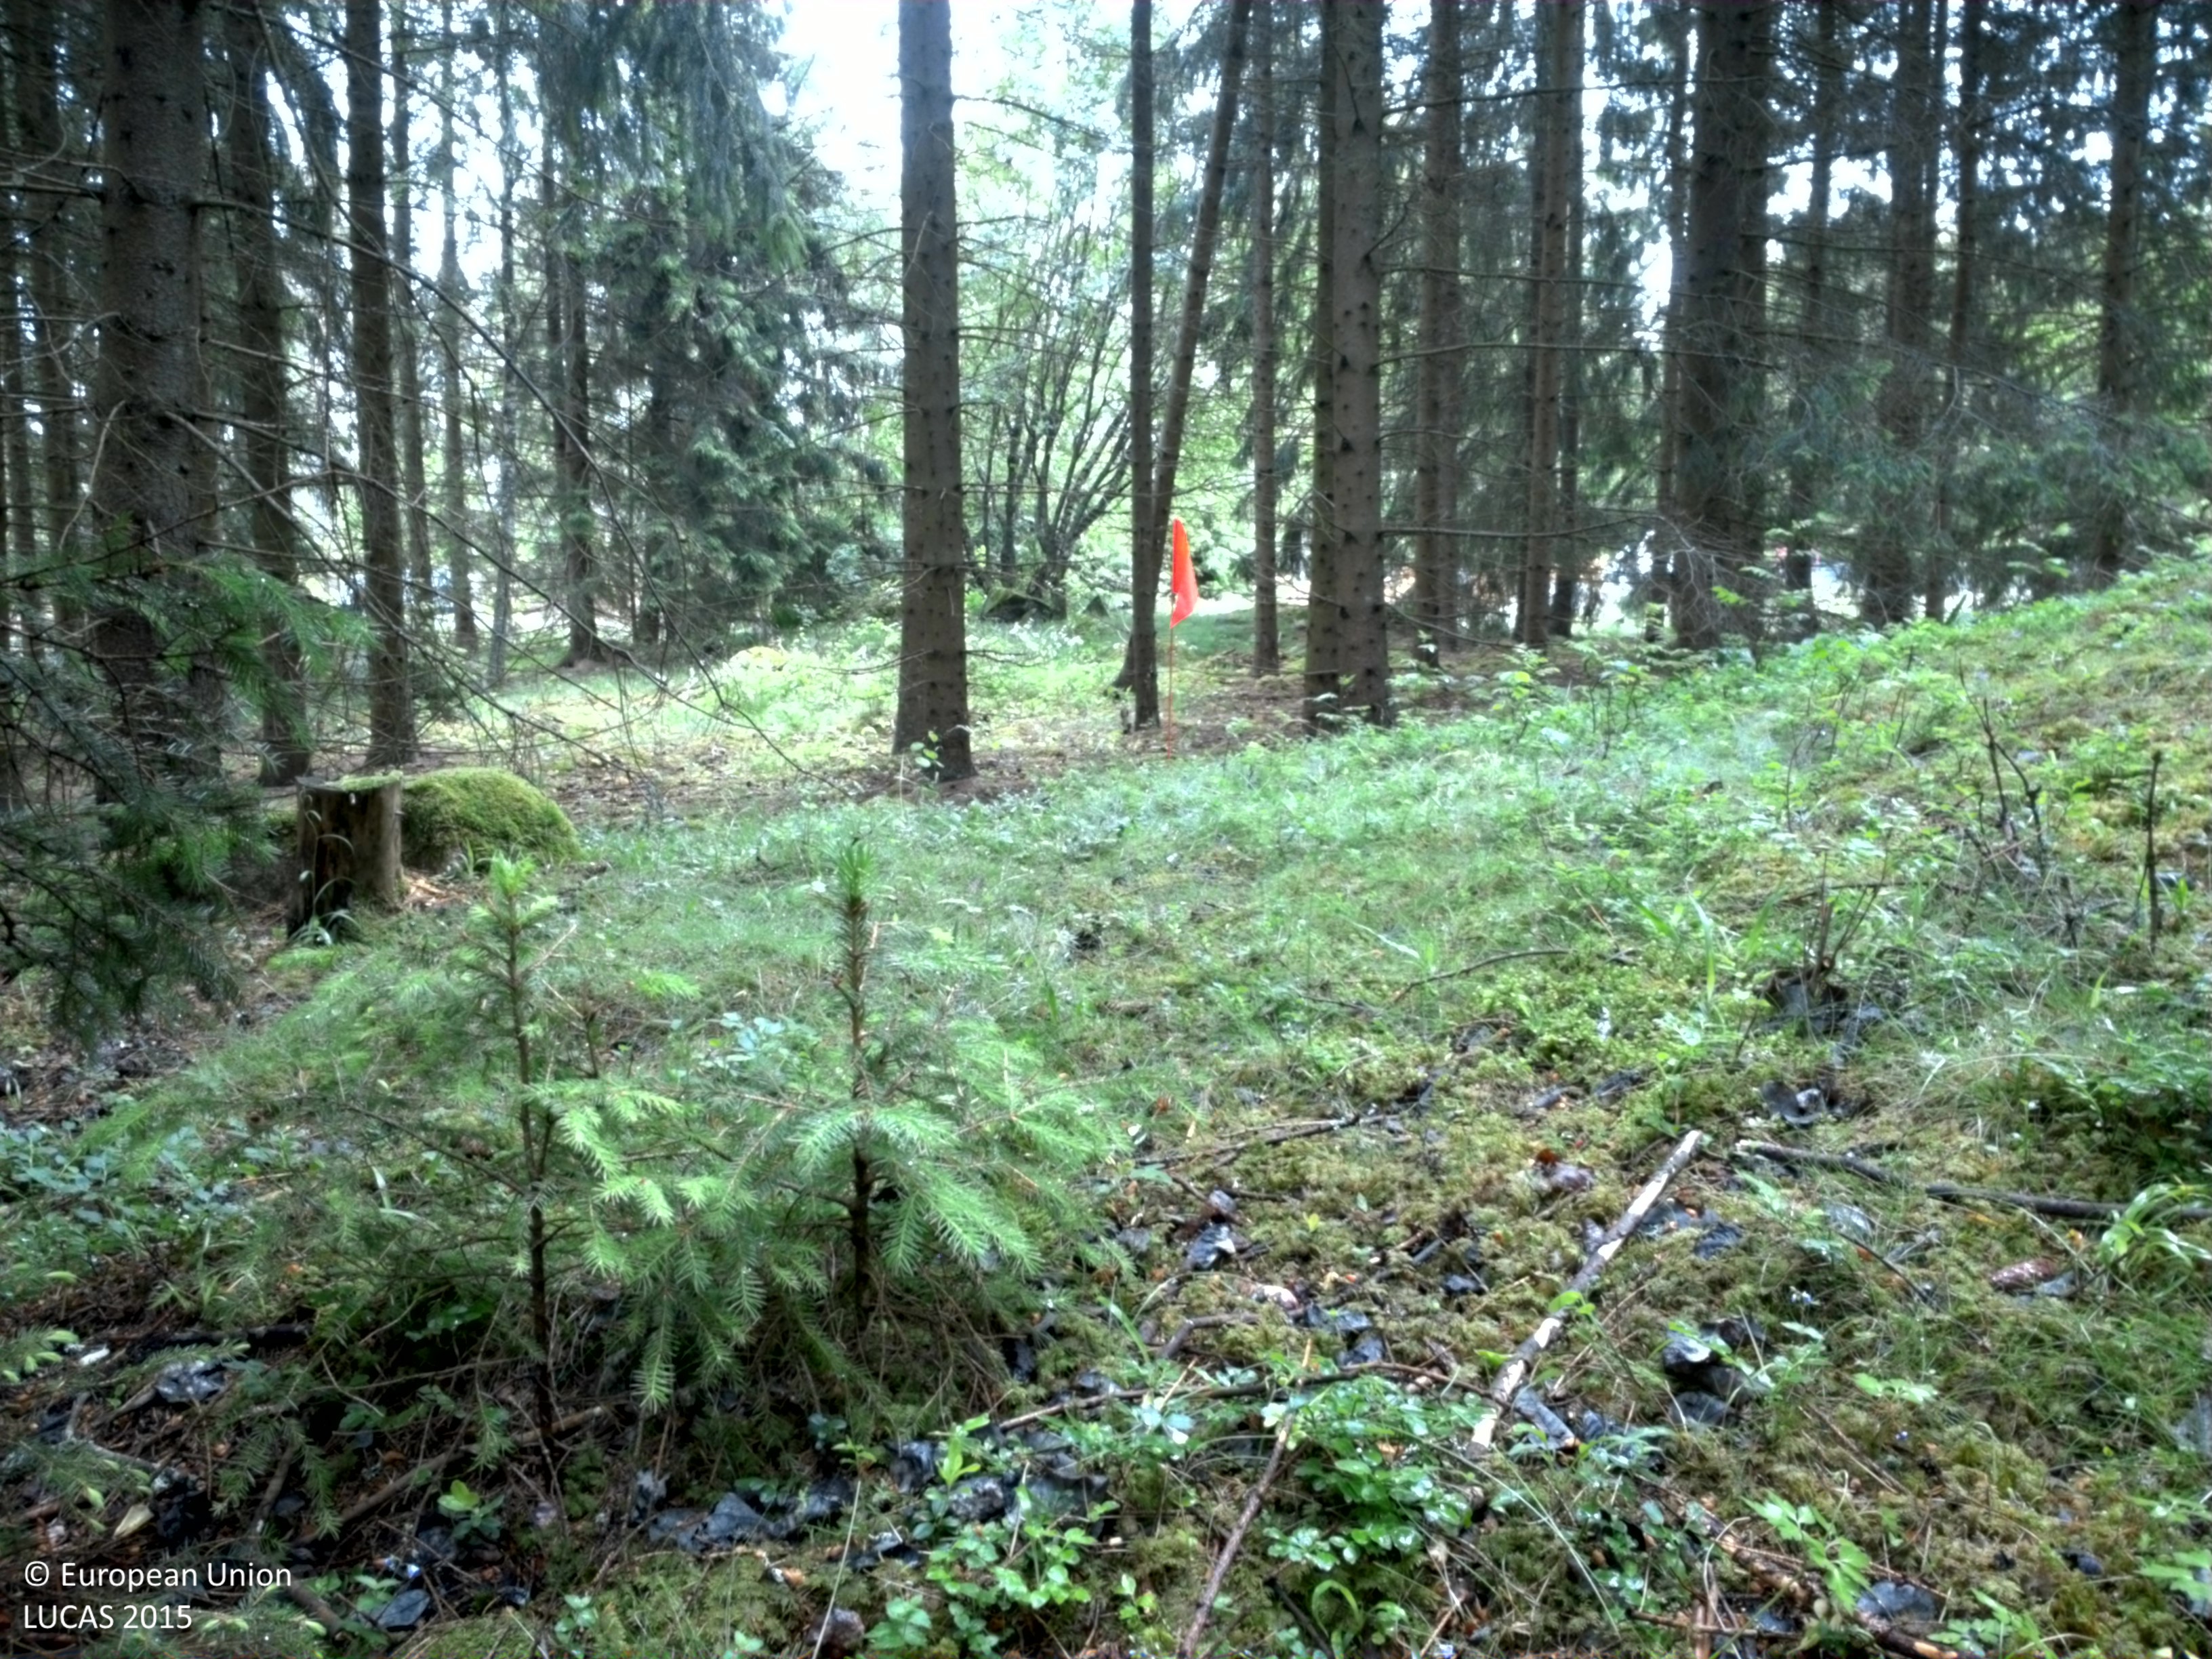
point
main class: Woodland
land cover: Spruce dominated coniferous woodland
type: boreal forest
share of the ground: > 75 %
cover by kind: coniferous forest trees 70 %, herbaceous plants 20 %, broadleaved forest trees 5 %, lichens and mosses 5 %
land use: Forestry
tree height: > 5 m
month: June
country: SE
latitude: 59.6273
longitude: 16.9970
